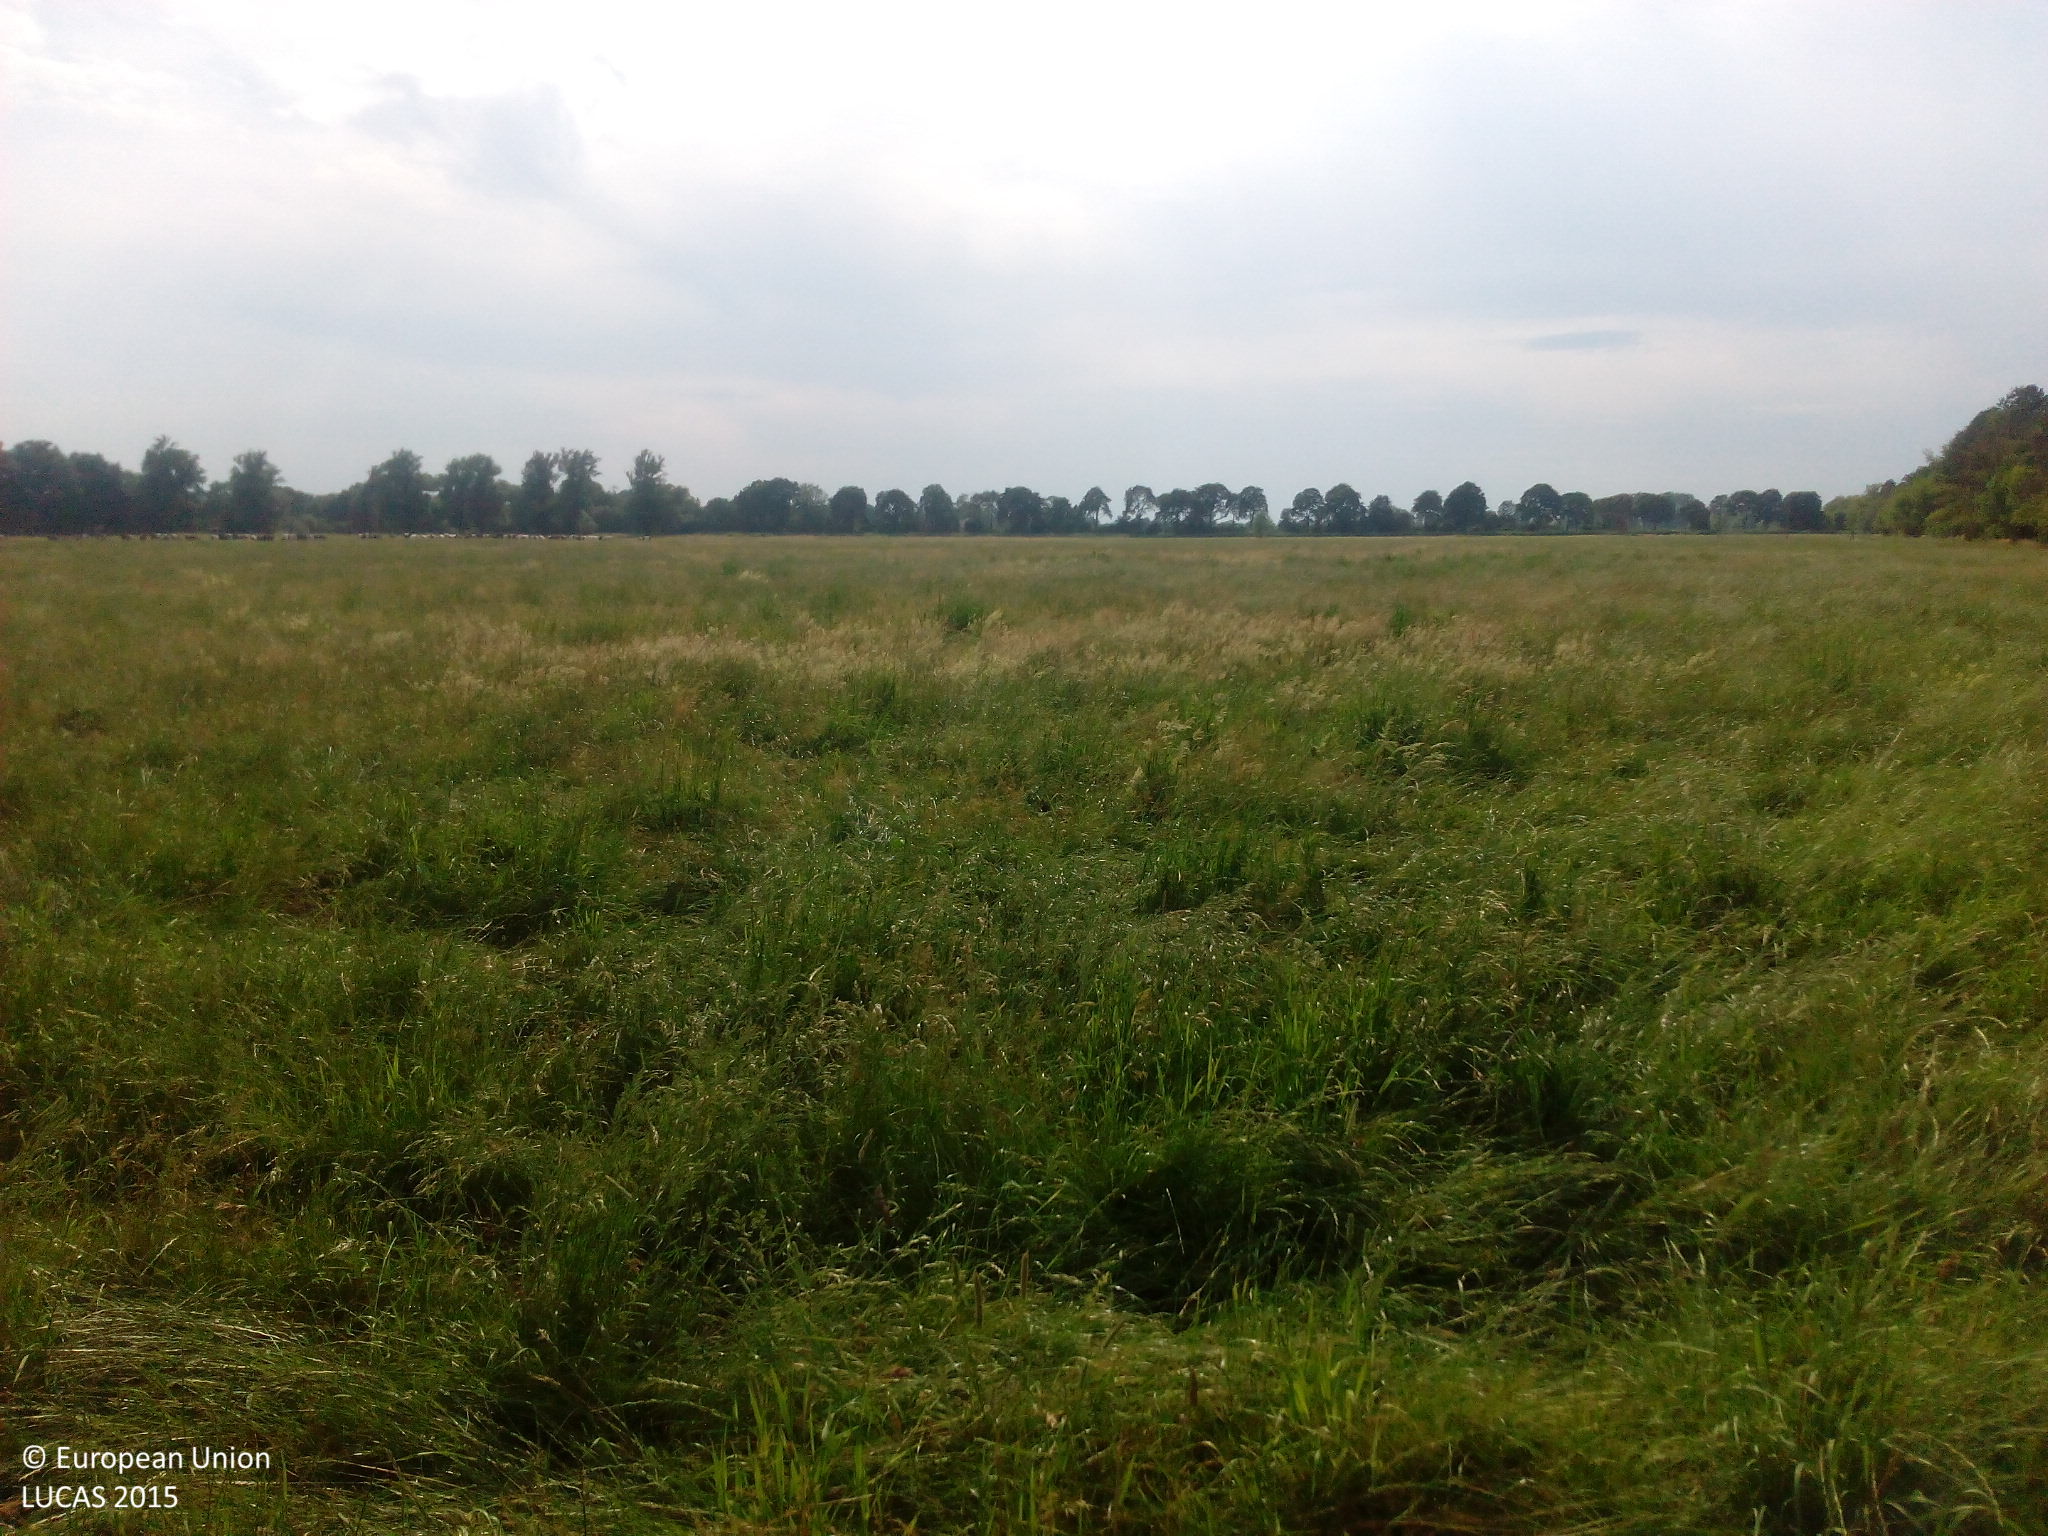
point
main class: Grassland
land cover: Grassland without tree/shrub cover
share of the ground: > 75 %
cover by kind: herbaceous plants 100 %
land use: Agriculture (excluding fallow land and kitchen gardens)
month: July
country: DE
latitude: 52.7659
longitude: 12.4449
